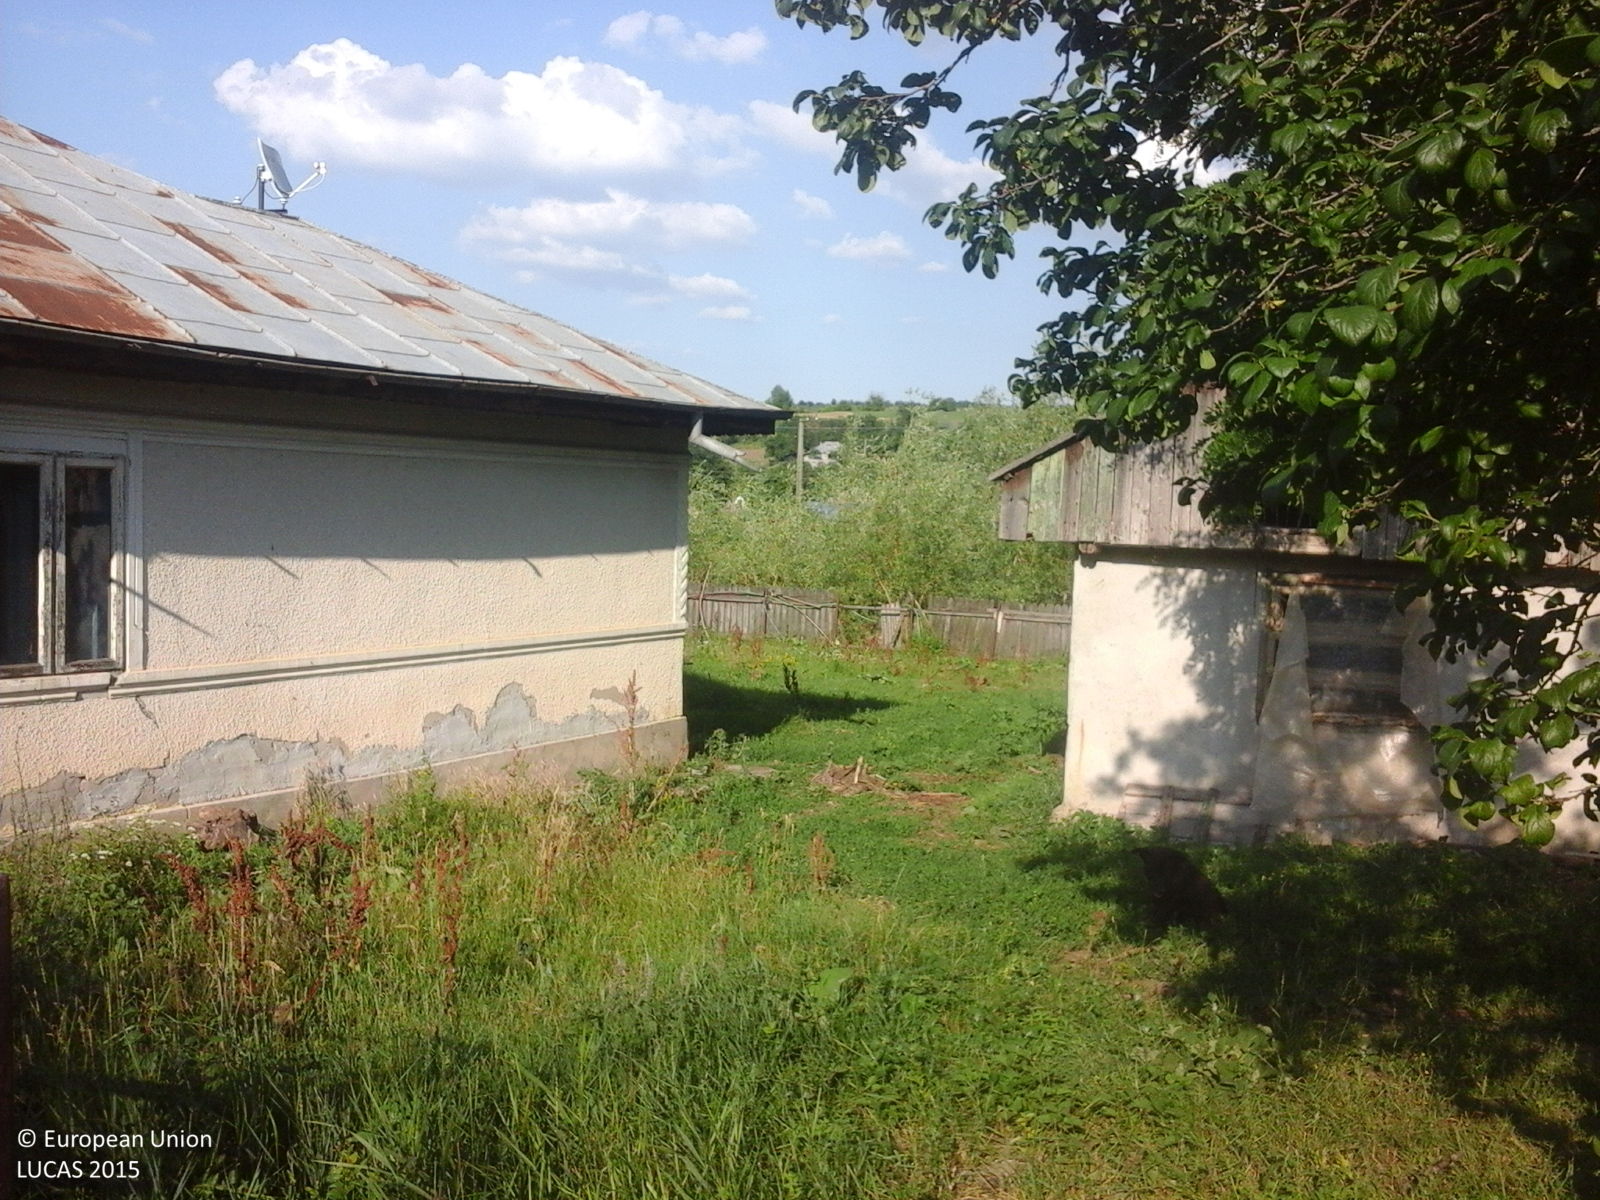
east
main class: Grassland
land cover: Grassland without tree/shrub cover
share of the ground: > 75 %
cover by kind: herbaceous plants 100 %
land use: Agriculture (excluding fallow land and kitchen gardens)
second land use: Residential
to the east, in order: Grassland without tree/shrub cover; Artificial constructions in urban areas; Grassland without tree/shrub cover; Abandoned hedges; Inland salty water bodies; Abandoned hedges; Fences; Grass margins; Tracks; Grass margins; Ditches and canals; Grass margins; Tracks; Grass margins; Maize; Electric lines; Grassland without tree/shrub cover; Fences; Grassland without tree/shrub cover; Fences; Grassland without tree/shrub cover; Tracks; Grassland without tree/shrub cover; Artificial constructions in urban areas; Maize; Grassland without tree/shrub cover
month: June
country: RO
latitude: 47.1618
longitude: 27.0255
